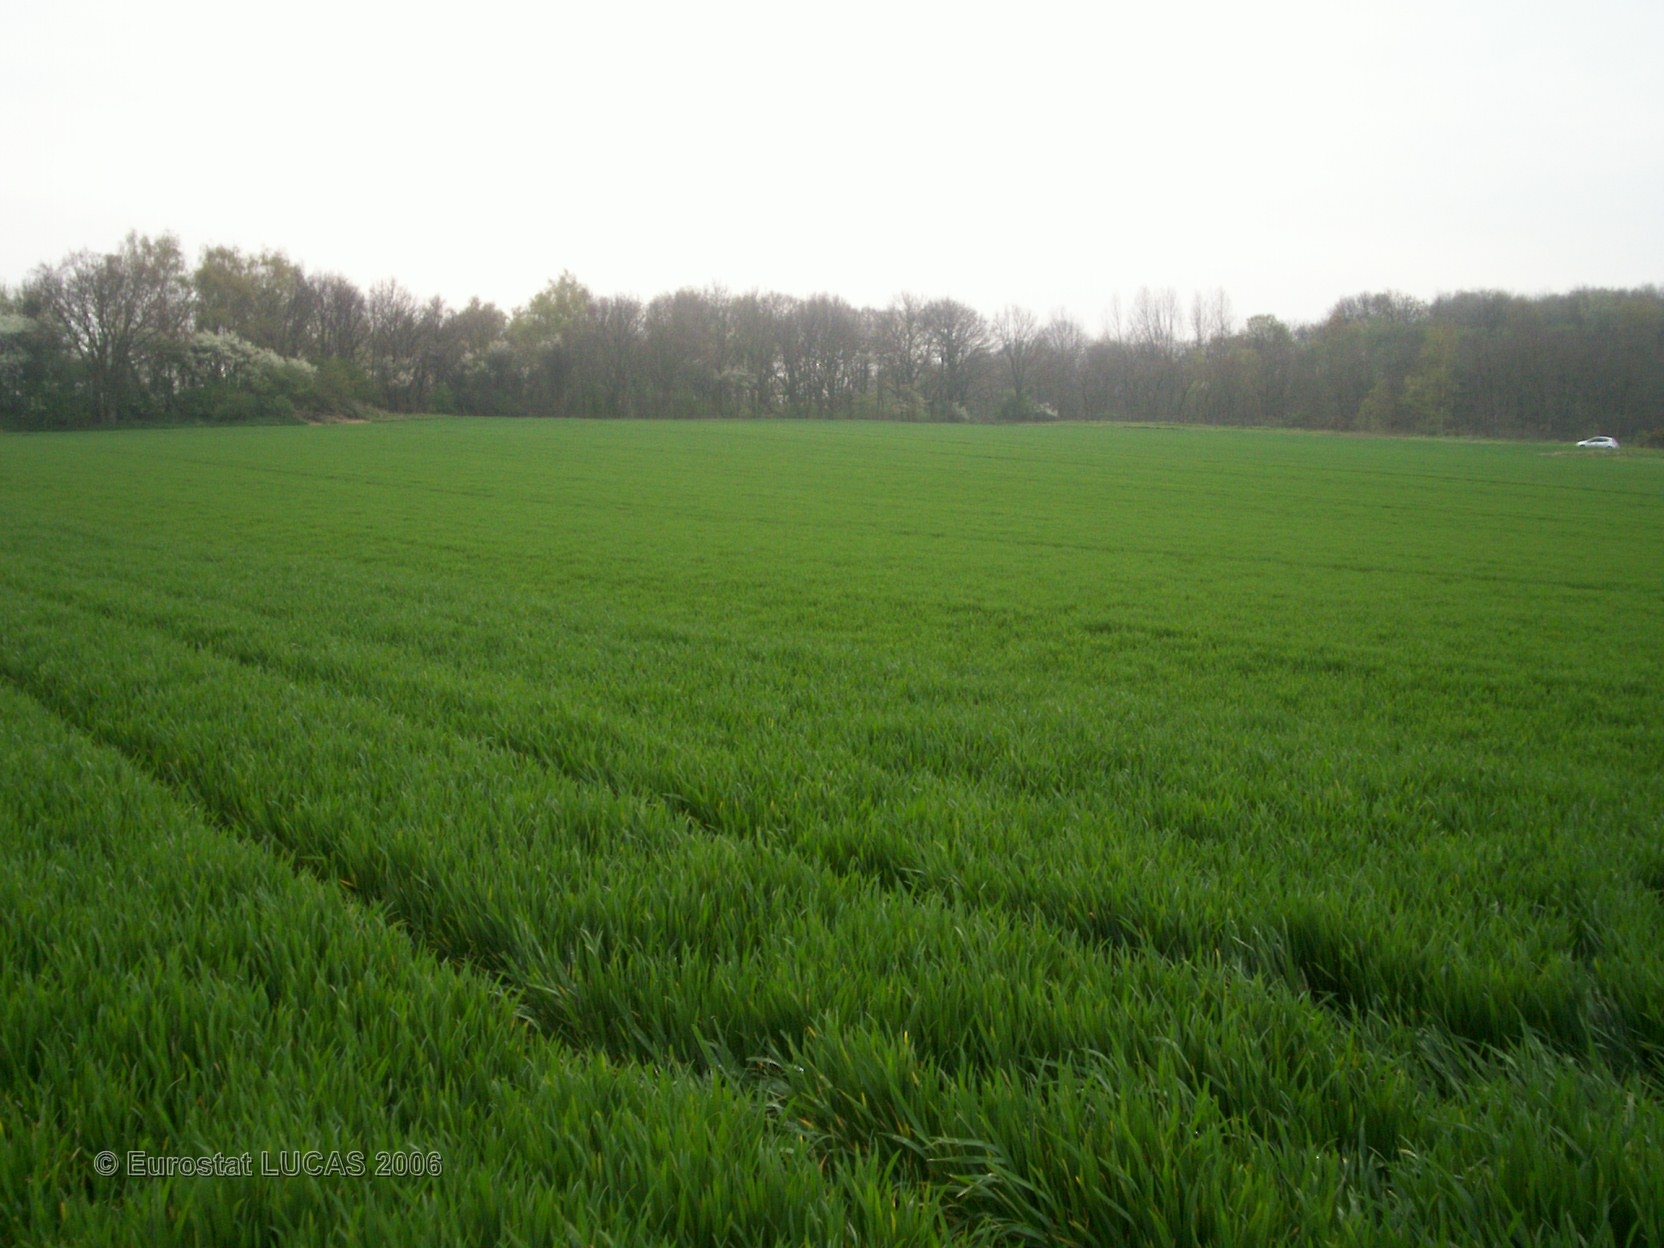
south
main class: Cropland
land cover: Common wheat
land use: Agriculture (excluding fallow land and kitchen gardens)
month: April
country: FR
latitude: 50.5204
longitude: 2.5830
